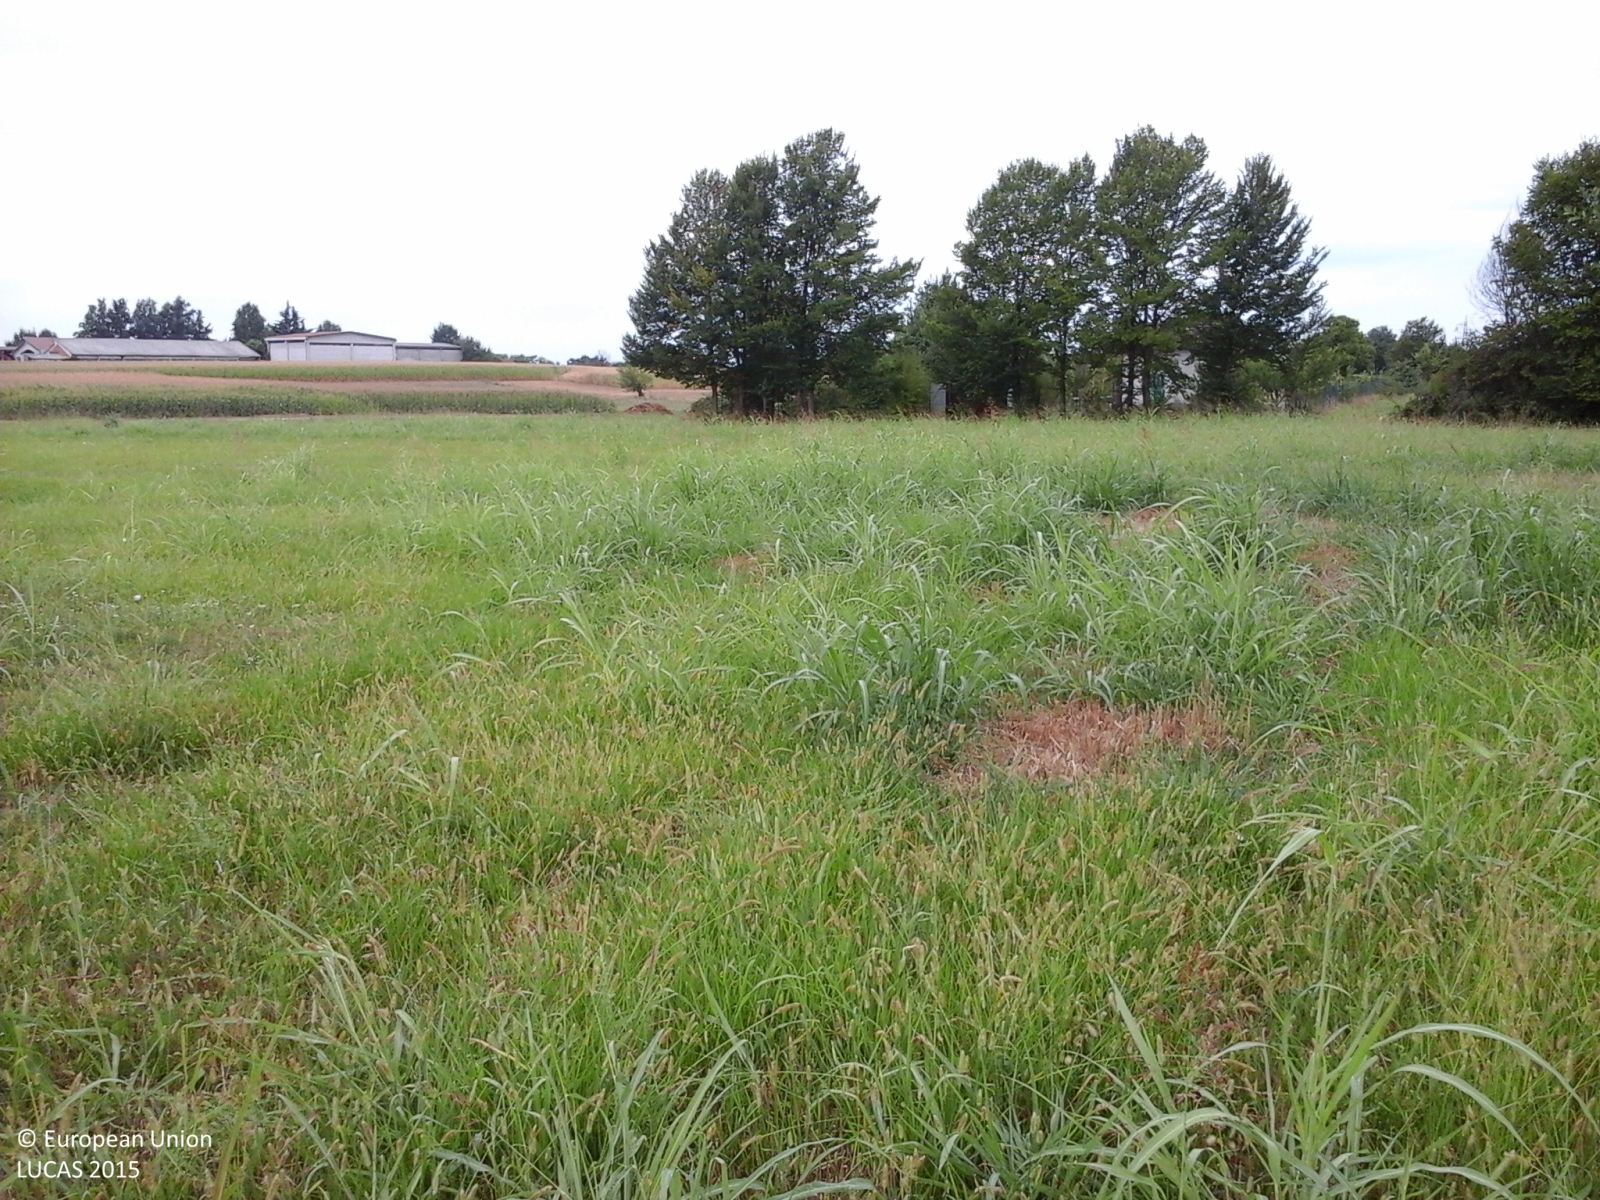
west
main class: Grassland
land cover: Spontaneously vegetated surfaces
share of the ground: > 75 %
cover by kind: herbaceous plants 100 %
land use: Agriculture (excluding fallow land and kitchen gardens)
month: July
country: IT
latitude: 44.7781
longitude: 7.7927
